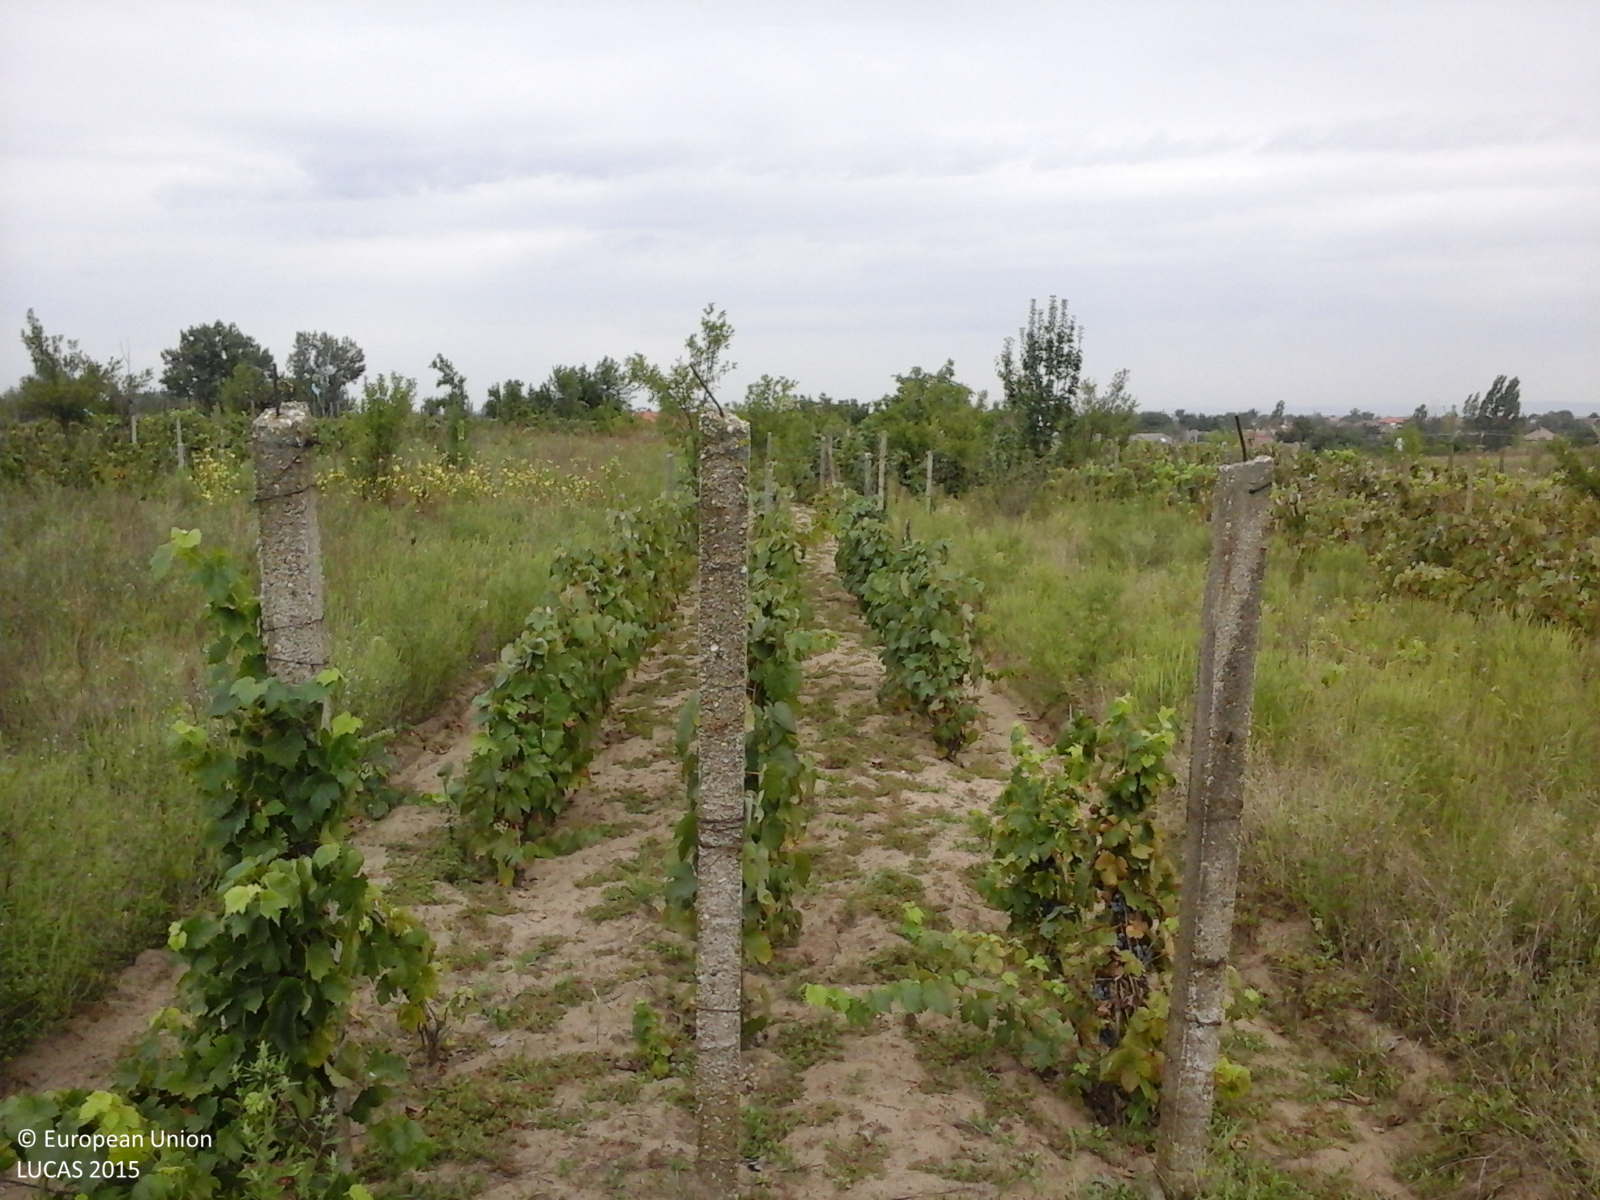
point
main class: Cropland
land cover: Vineyards
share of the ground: > 75 %
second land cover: Spontaneously vegetated surfaces
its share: > 75 %
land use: Agriculture (excluding fallow land and kitchen gardens)
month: September
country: RO
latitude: 47.5153
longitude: 22.1221
